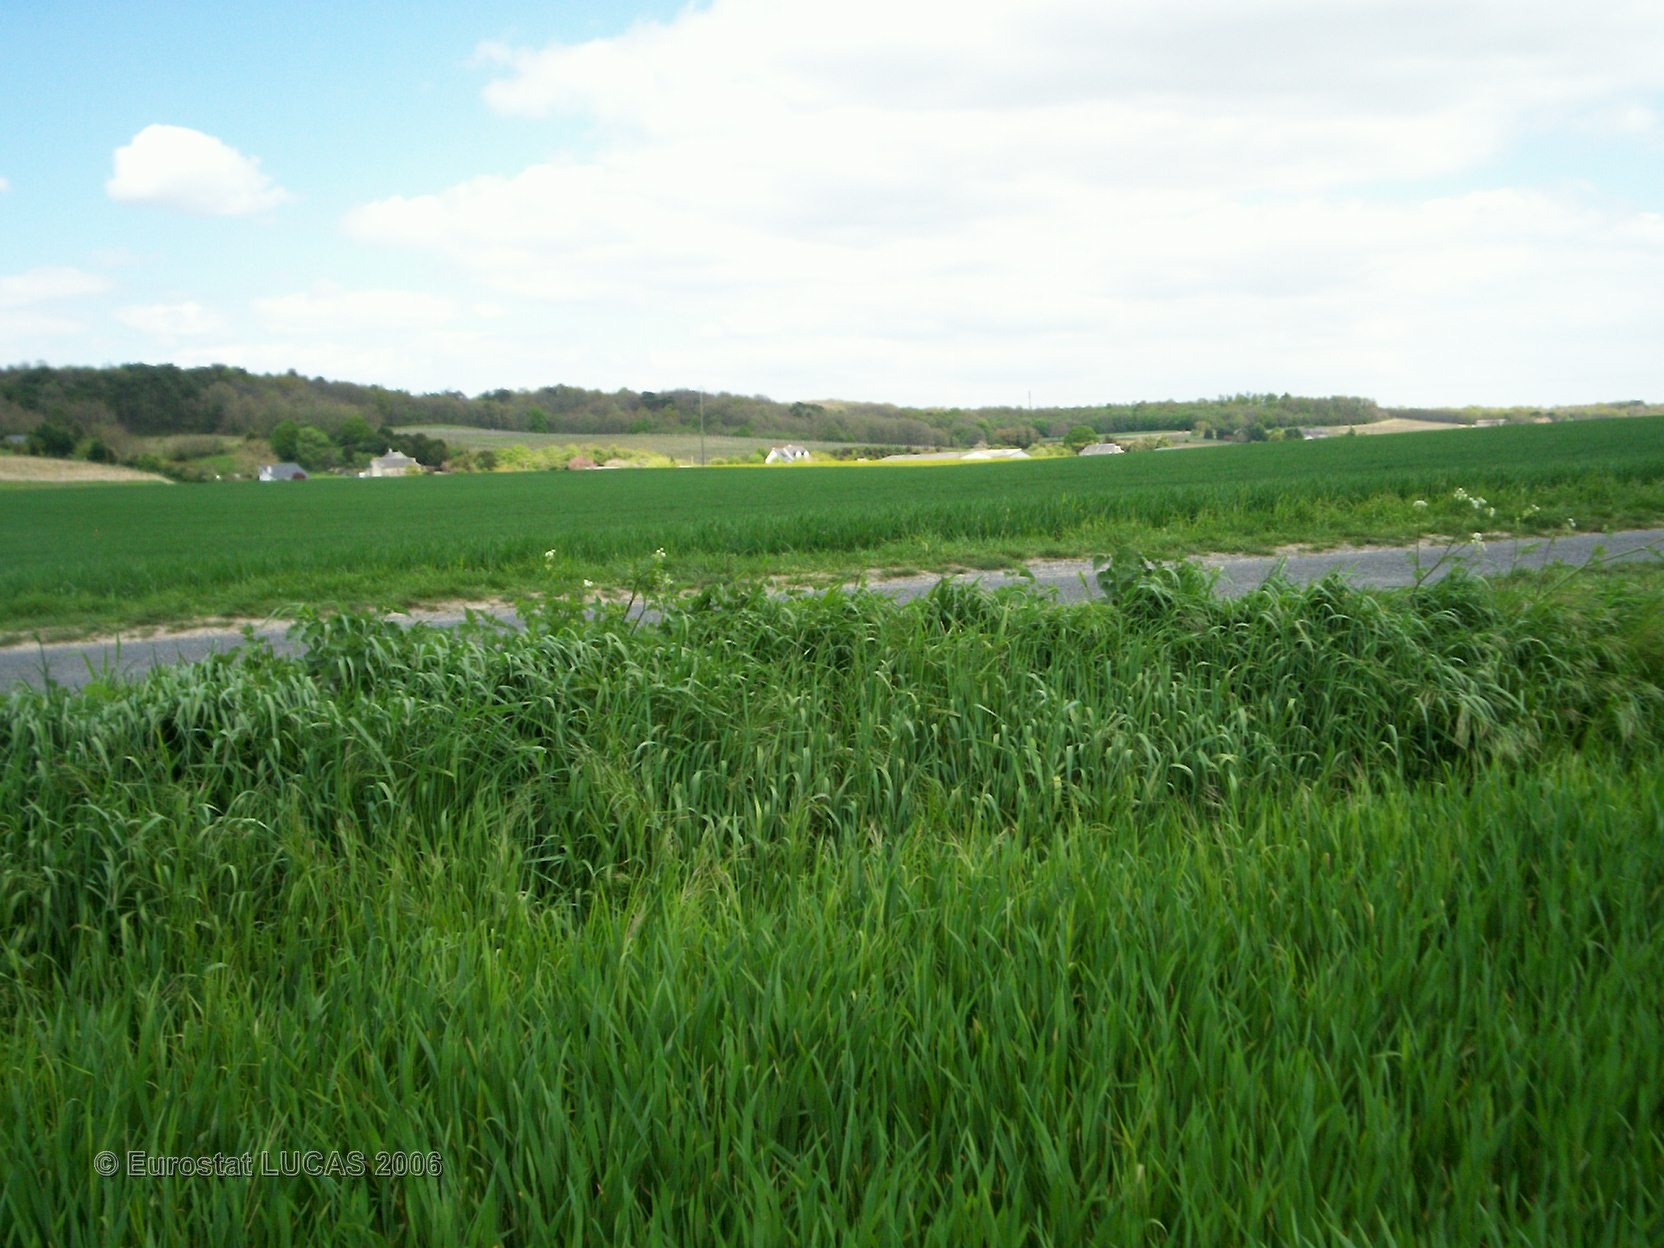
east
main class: Cropland
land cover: Common wheat
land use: Agriculture (excluding fallow land and kitchen gardens)
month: April
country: FR
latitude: 47.1340
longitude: 0.2080
